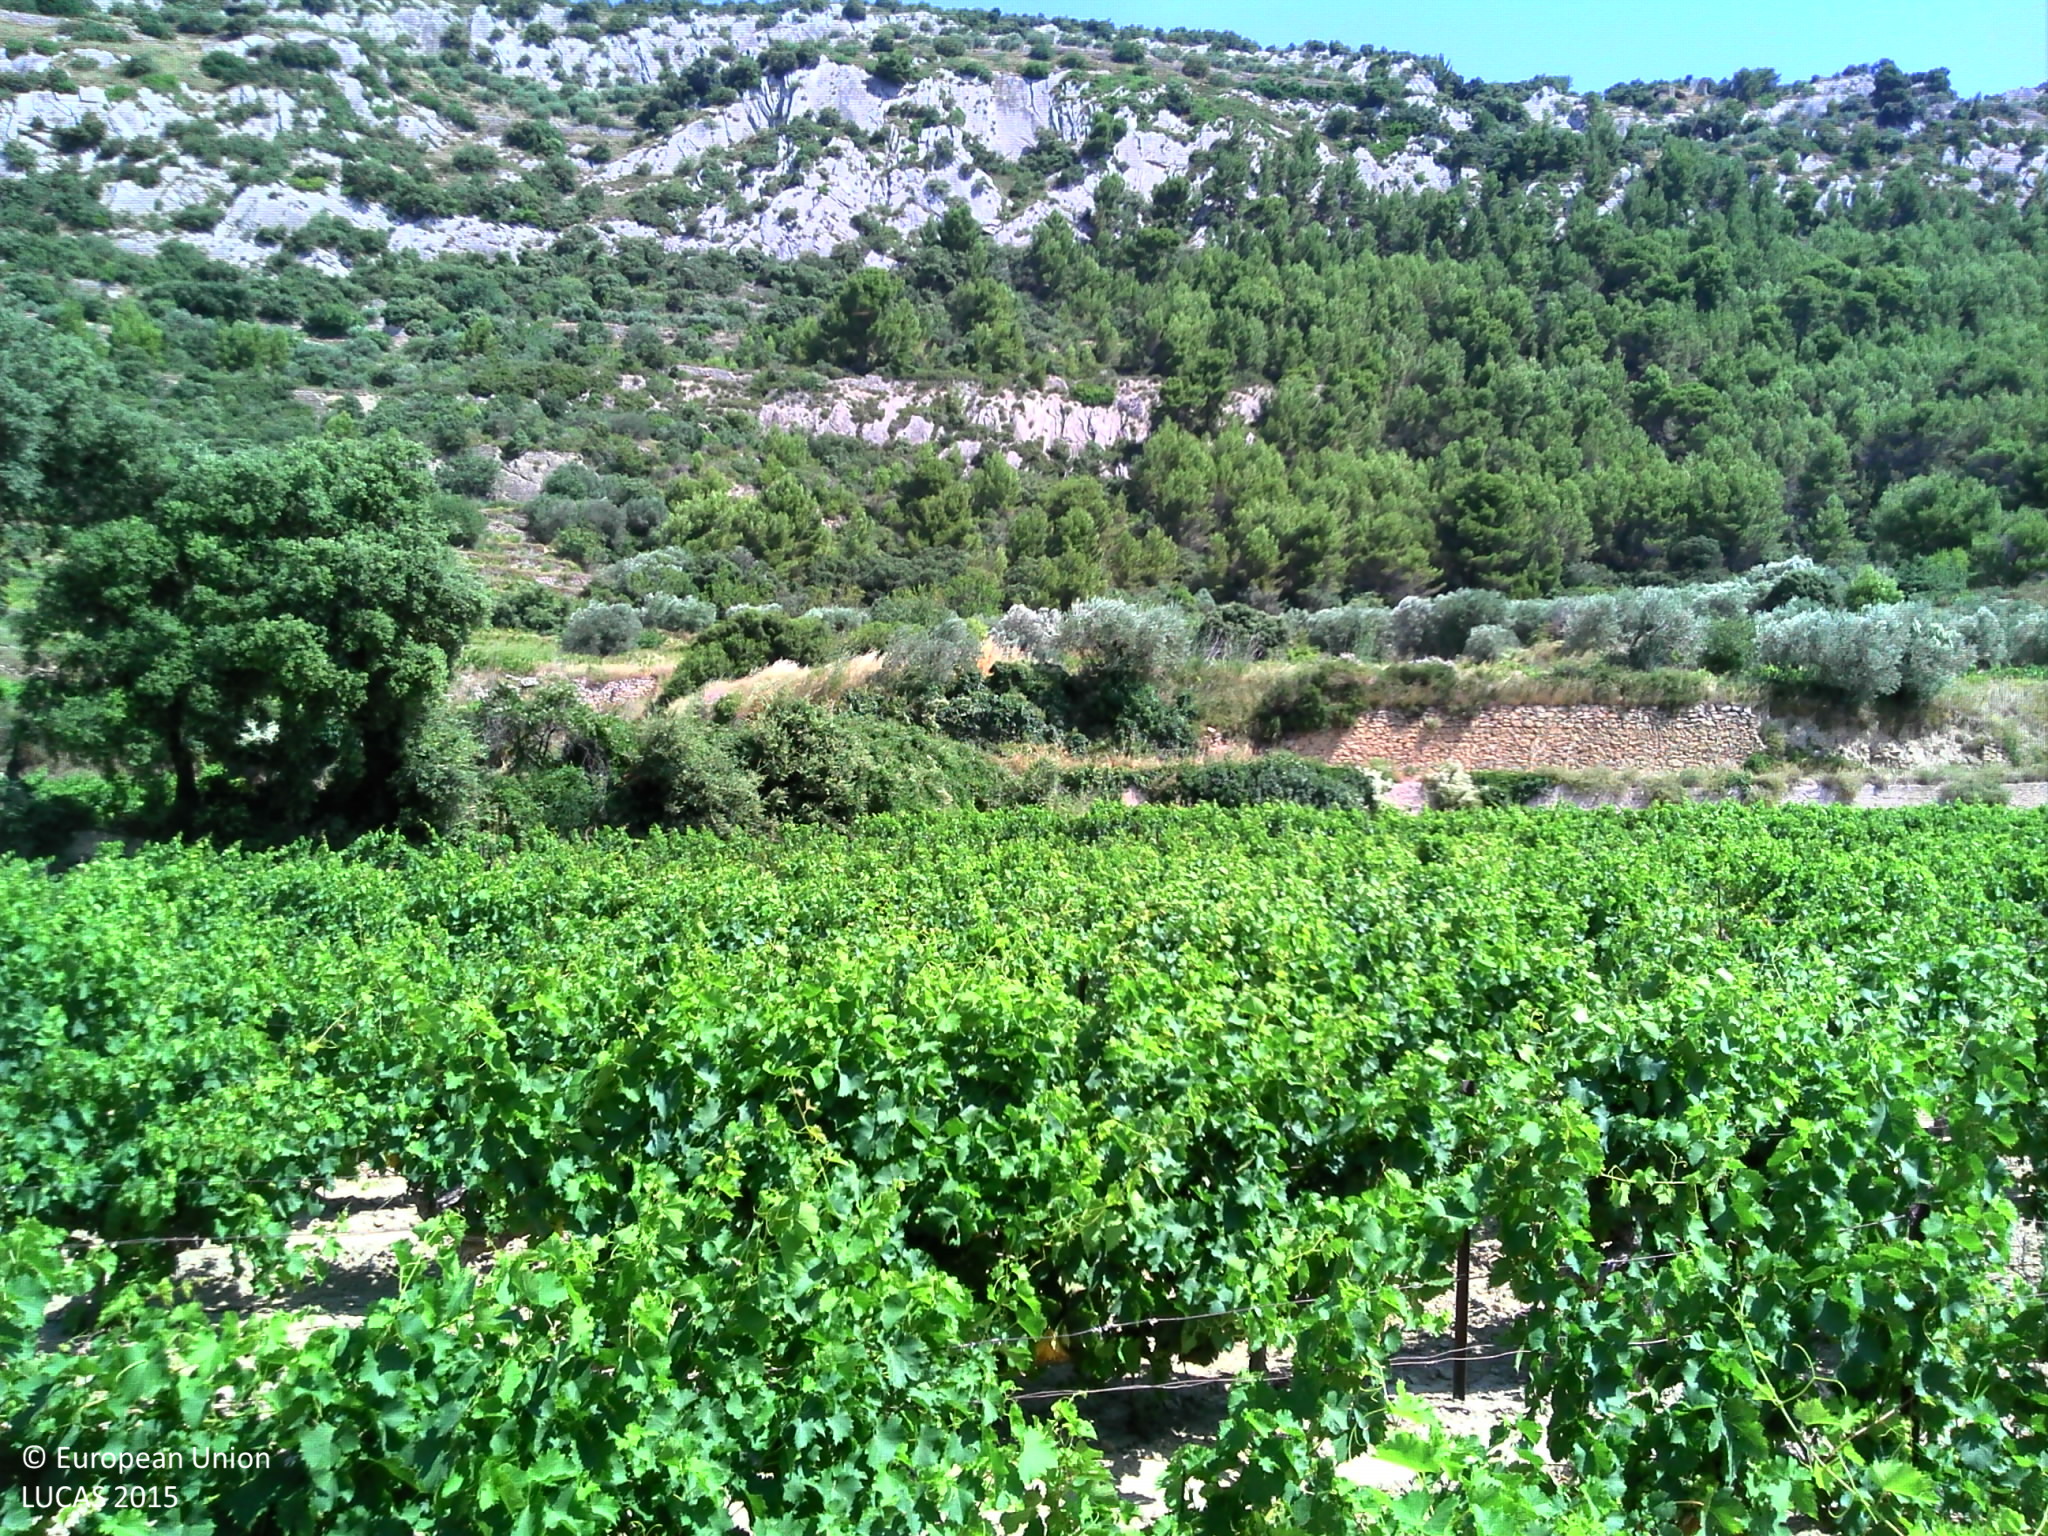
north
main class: Cropland
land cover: Vineyards
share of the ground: > 75 %
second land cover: Other bare soil
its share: > 75 %
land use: Agriculture (excluding fallow land and kitchen gardens)
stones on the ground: < 10 %
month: July
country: FR
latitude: 44.1227
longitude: 5.0219
